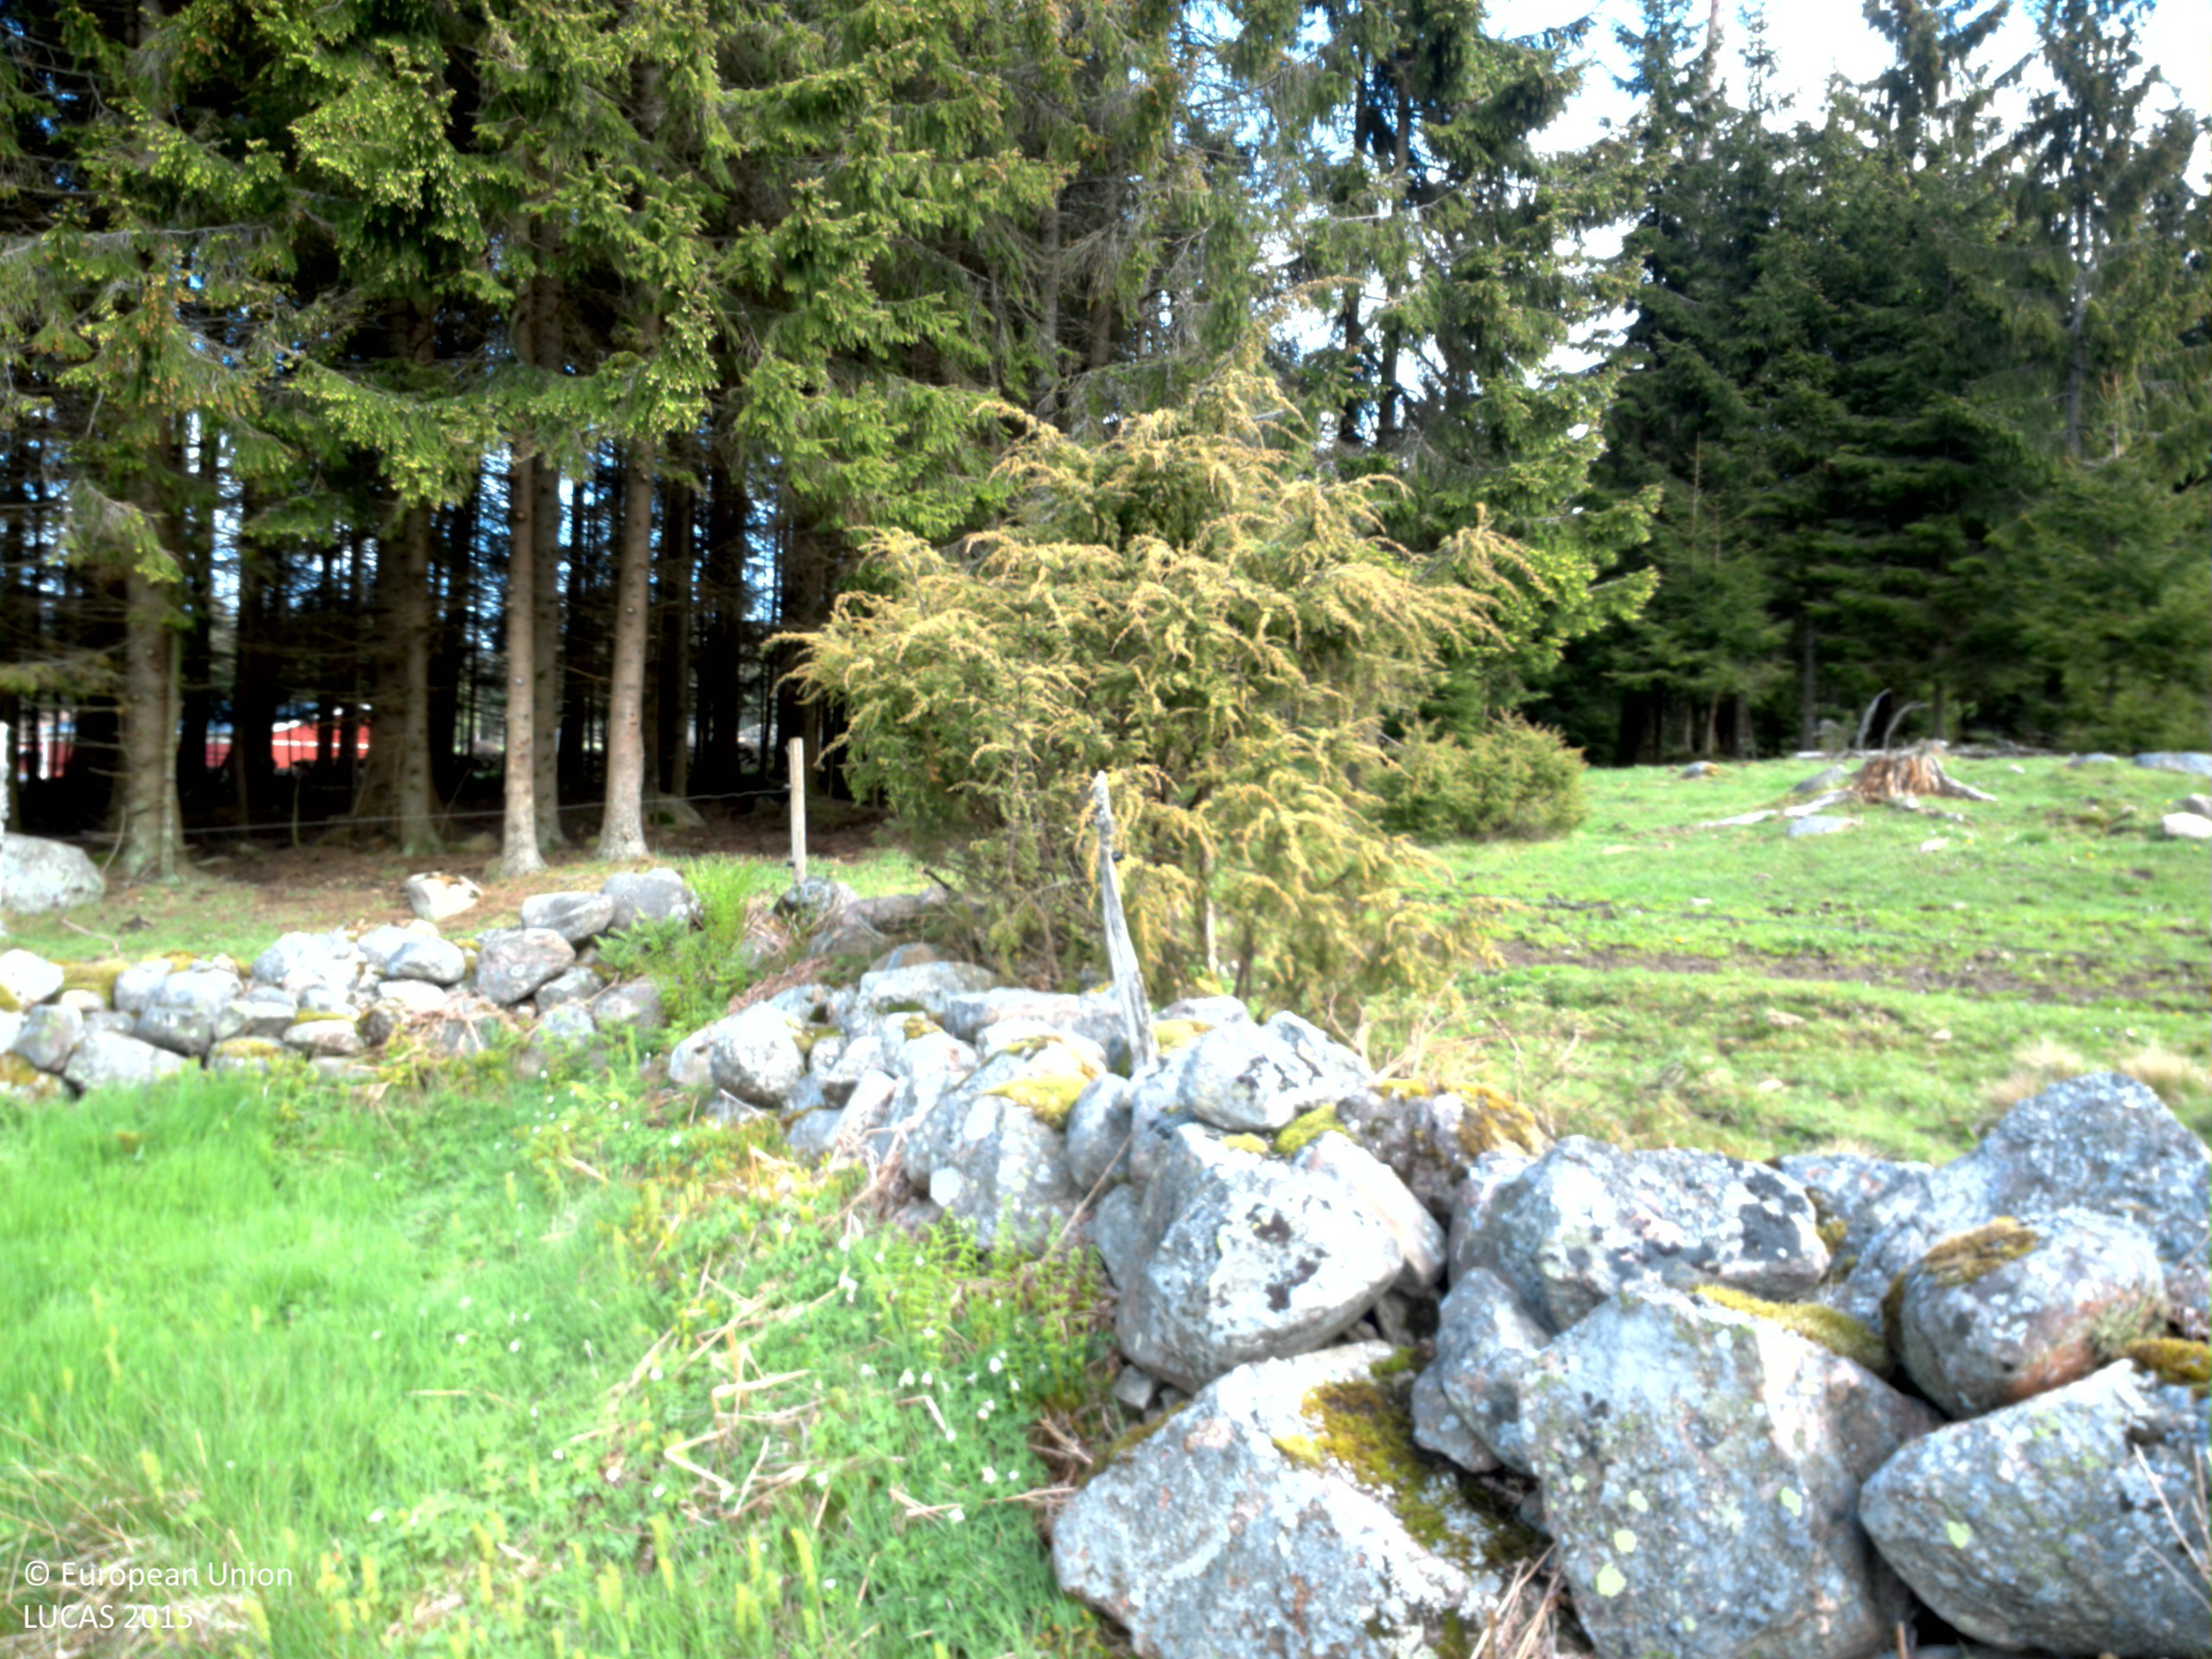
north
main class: Grassland
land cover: Grassland without tree/shrub cover
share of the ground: > 75 %
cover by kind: herbaceous plants 100 %
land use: Agriculture (excluding fallow land and kitchen gardens)
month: May
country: SE
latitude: 57.8431
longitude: 13.0444
